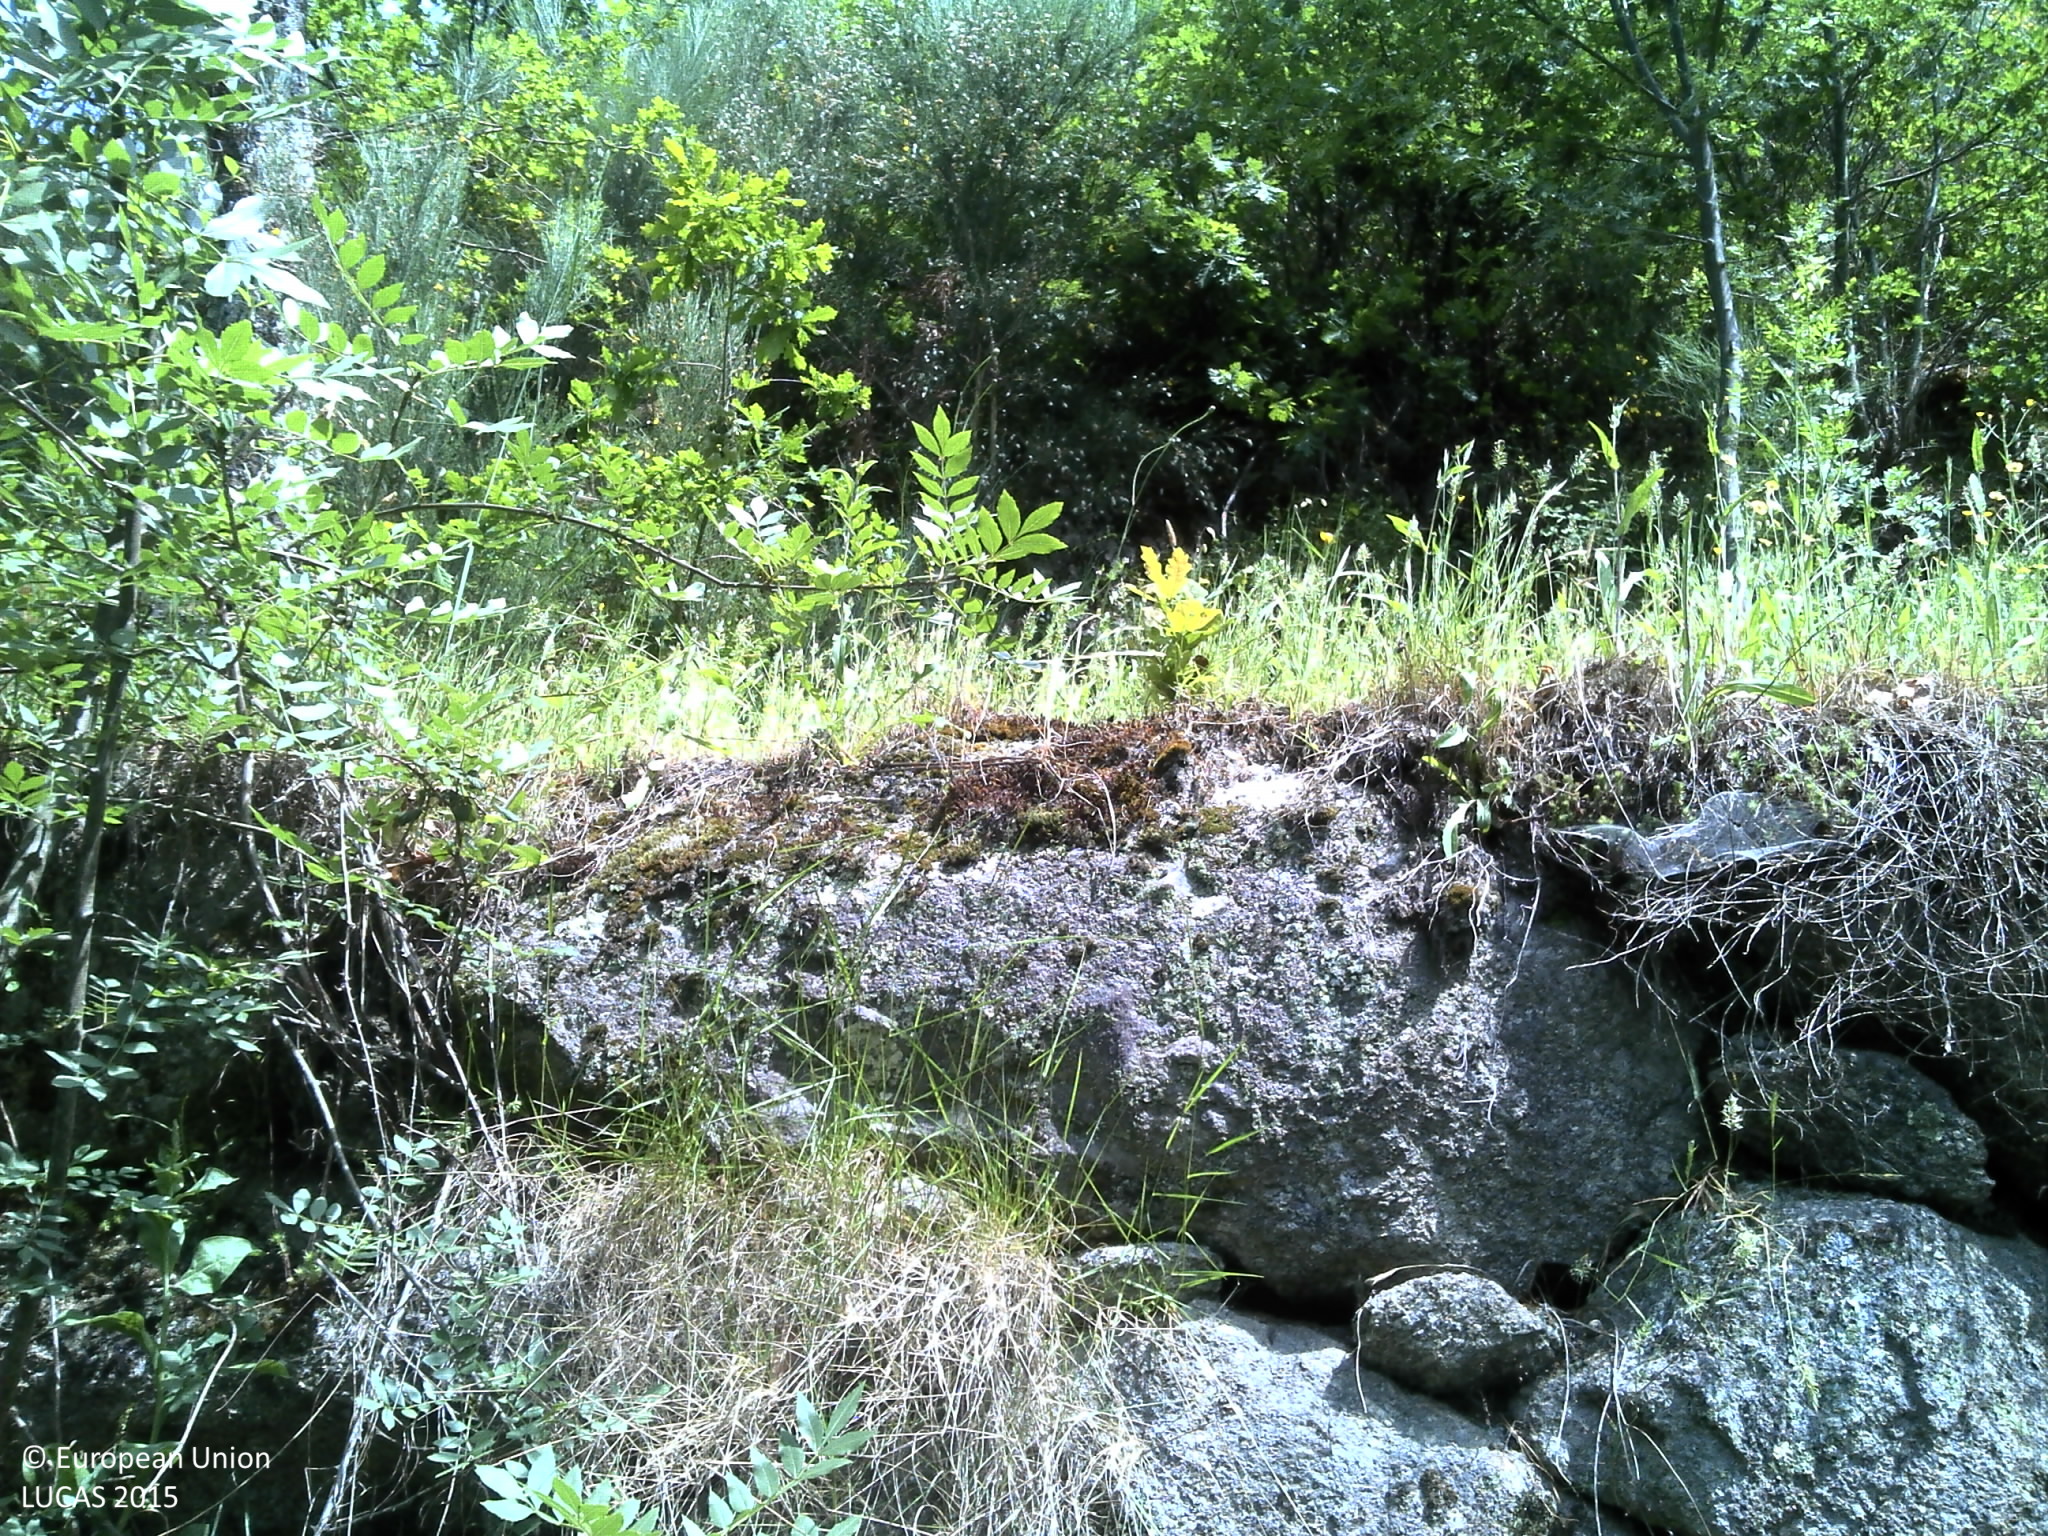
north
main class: Woodland
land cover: Broadleaved woodland
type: acidophilous oak and oak-birch forest
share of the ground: 50 - 75 %
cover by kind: broadleaved forest trees 70 %, herbaceous plants 25 %, unconsolidated bare surface 5 %
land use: Forestry
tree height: > 5 m
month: May
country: PT
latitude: 41.0198
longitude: -8.0313
